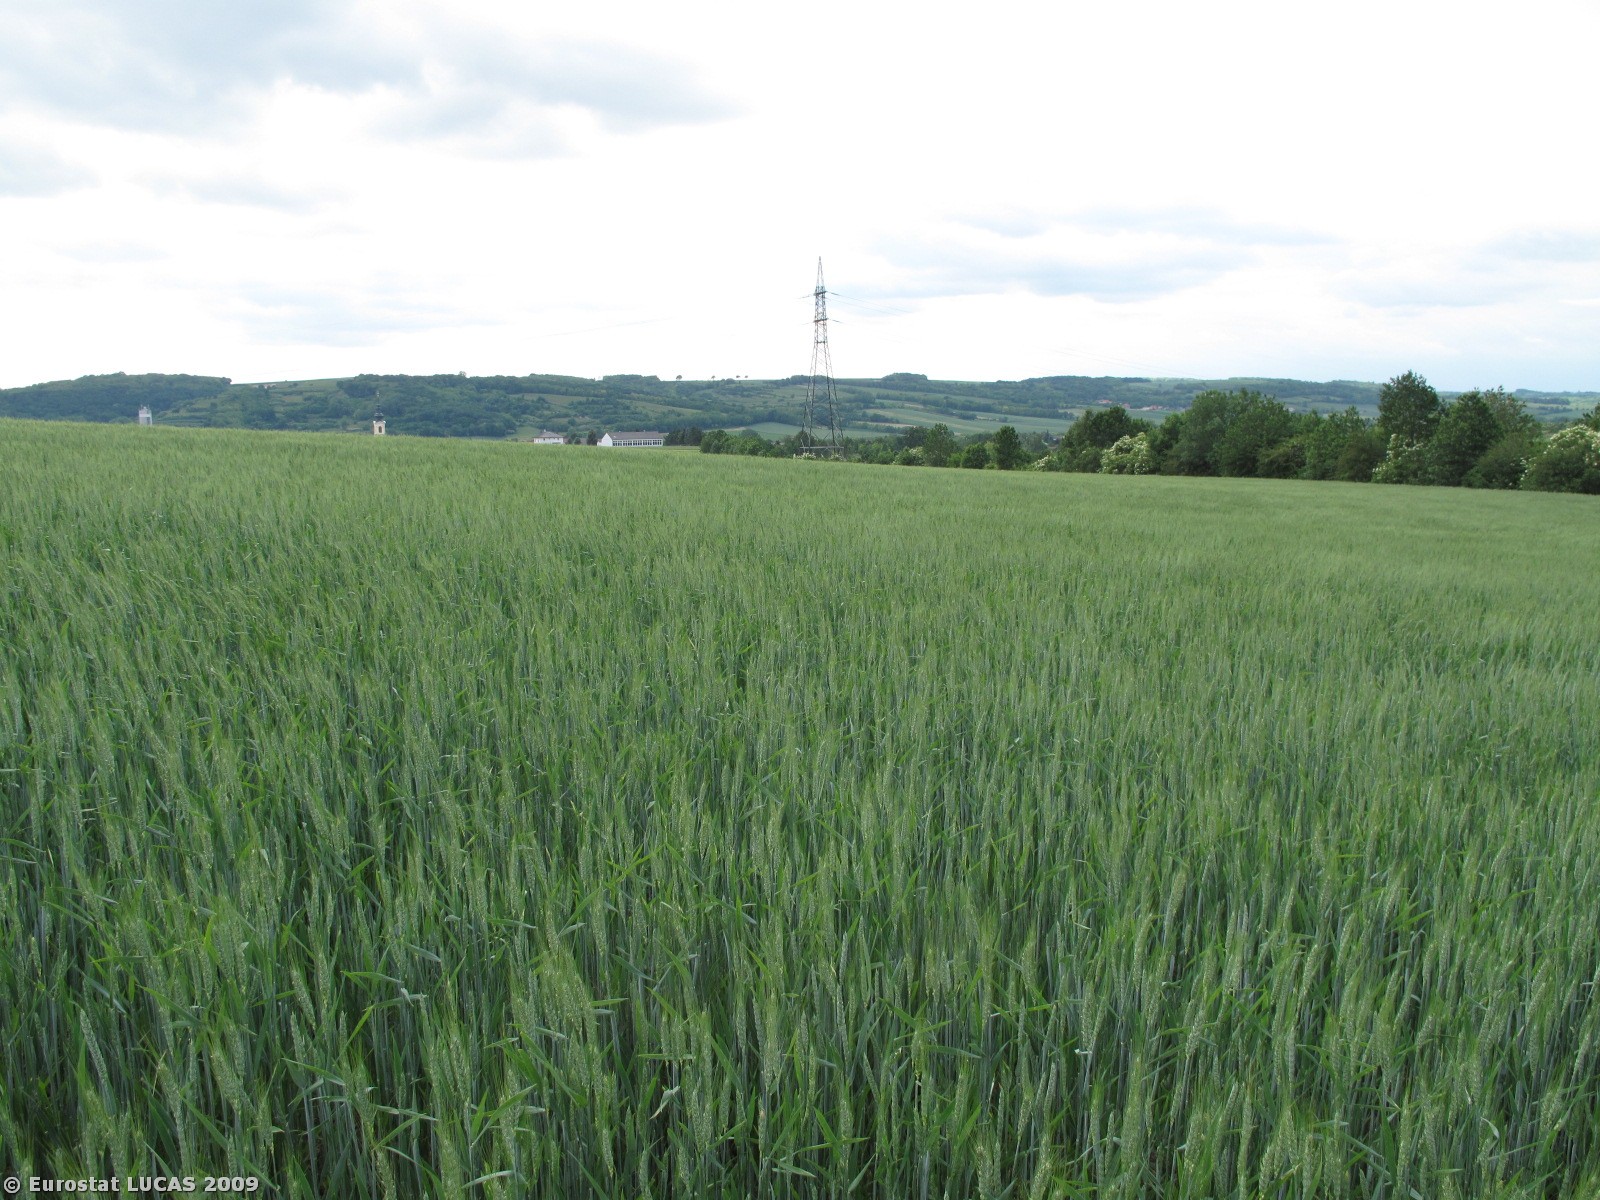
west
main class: Cropland
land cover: Common wheat
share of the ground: > 75 %
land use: Agriculture (excluding fallow land and kitchen gardens)
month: May
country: AT
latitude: 48.4753
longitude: 15.9967
